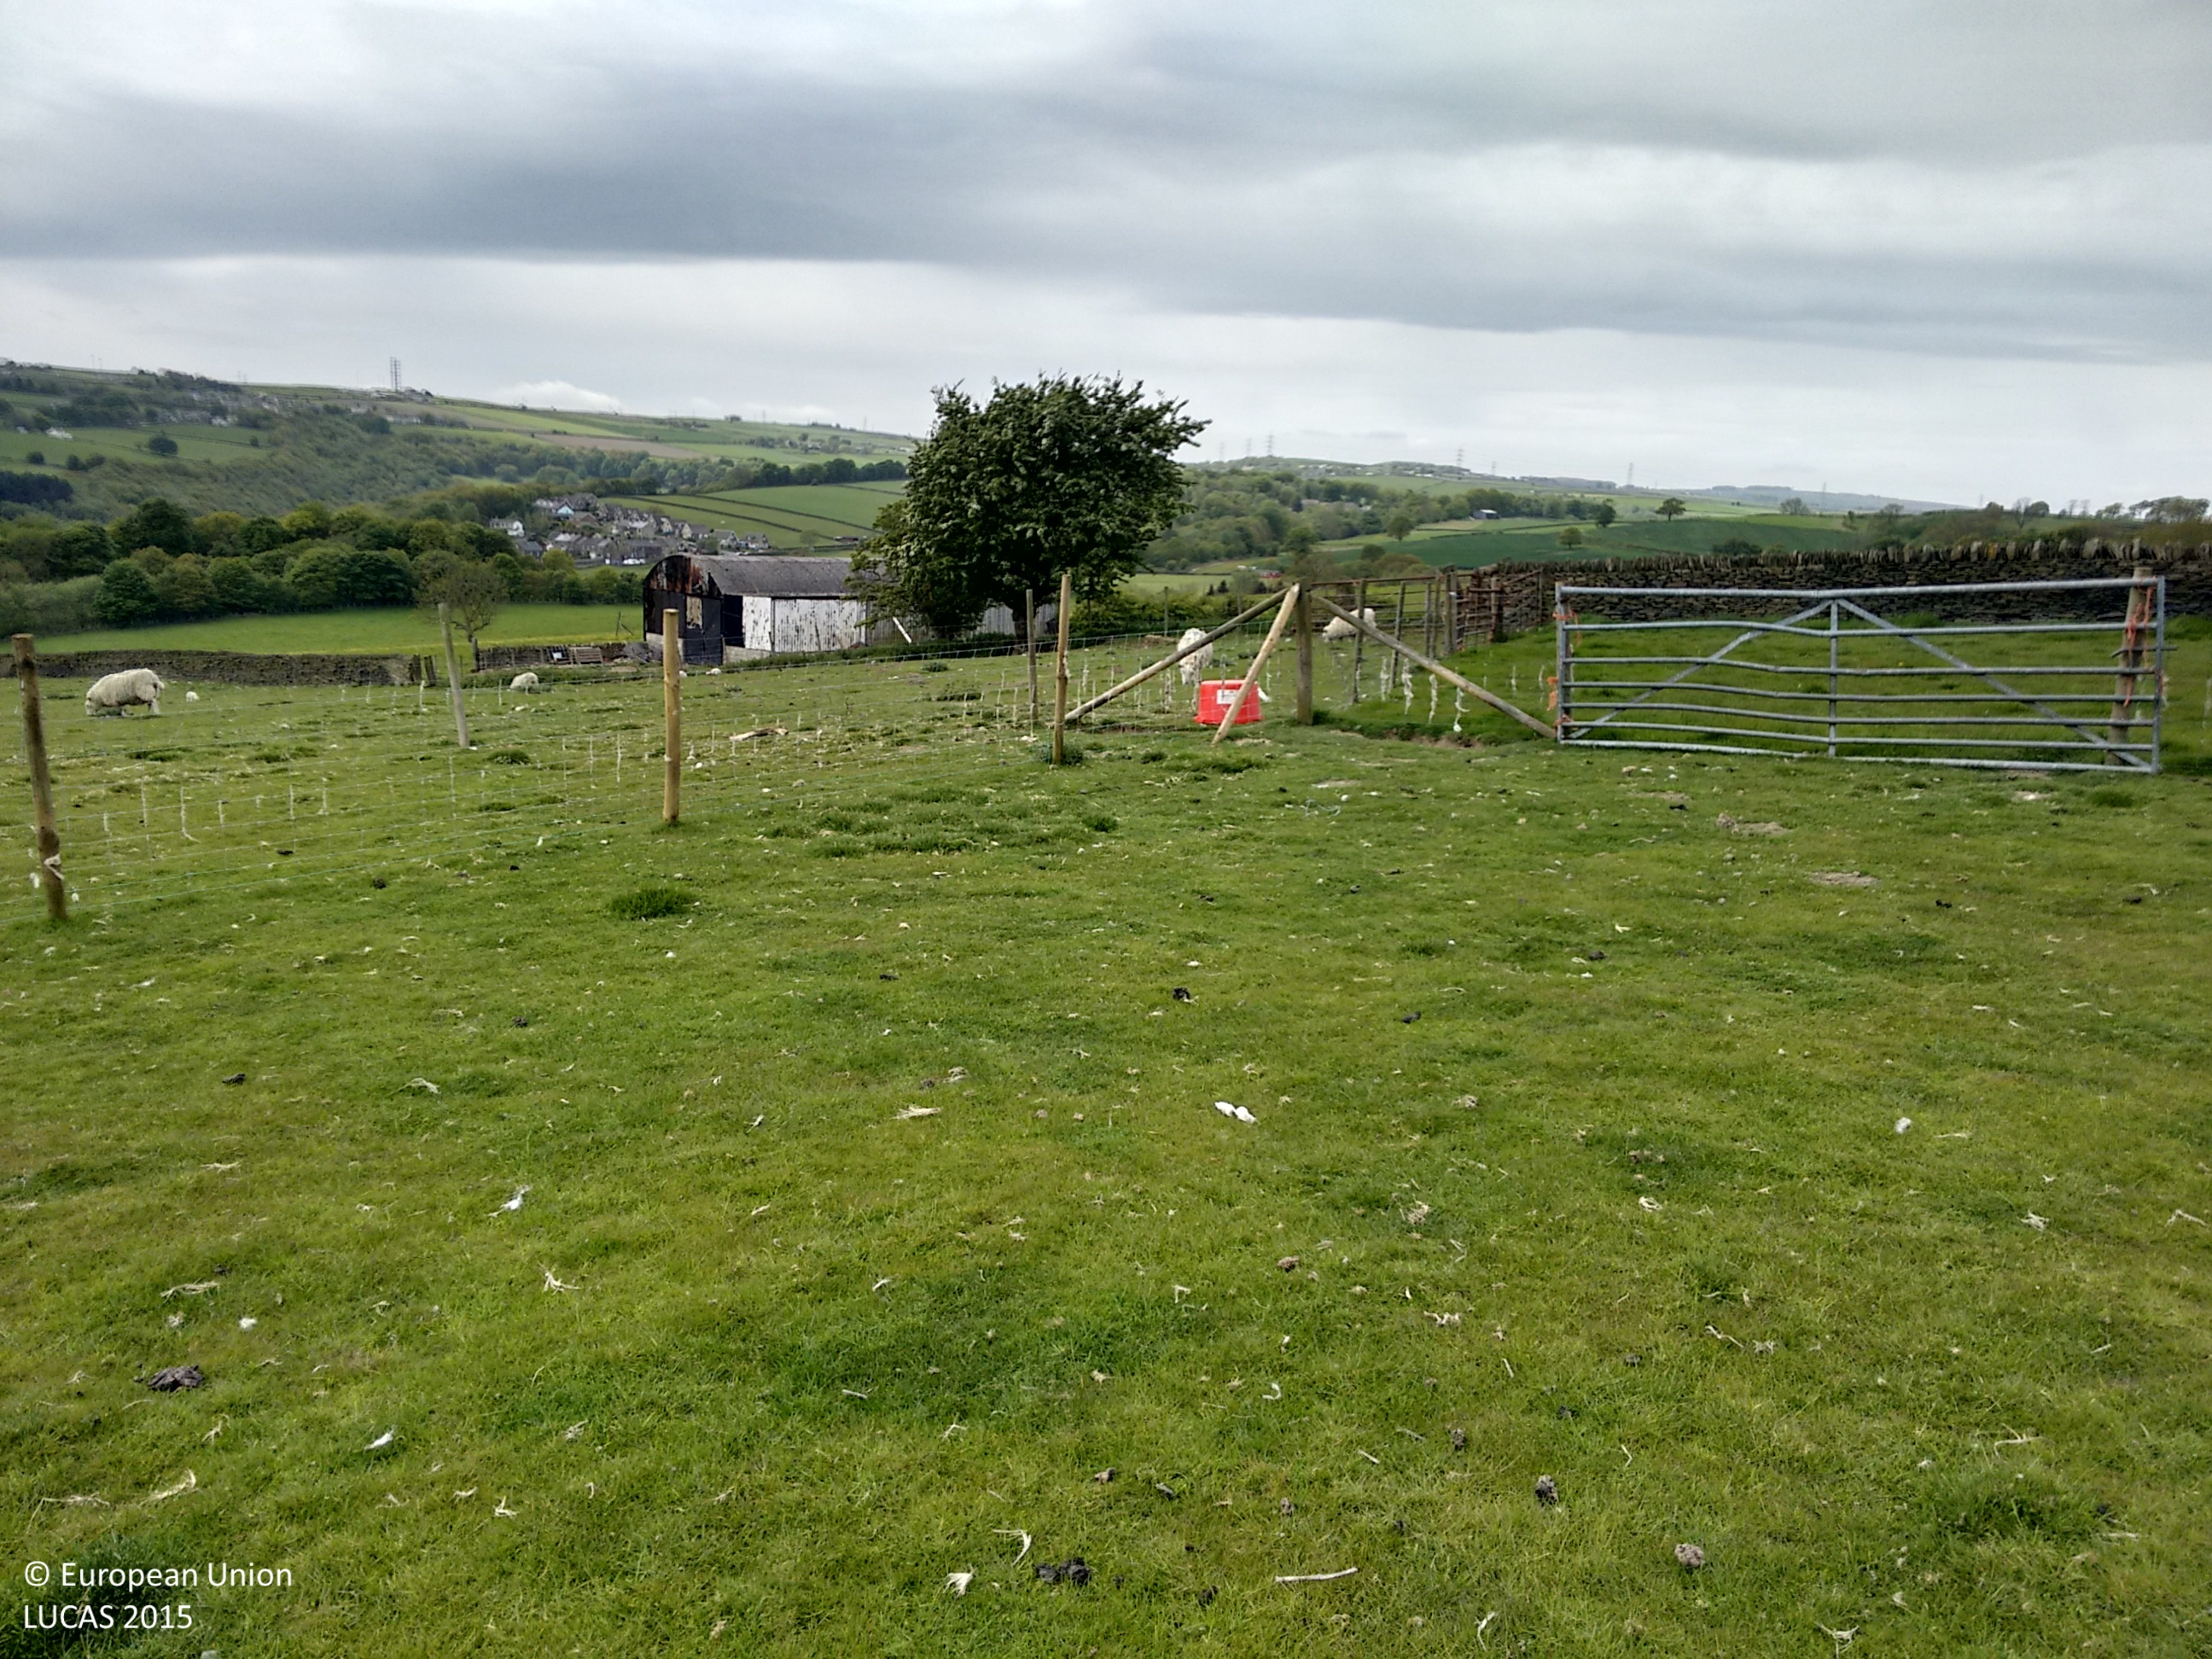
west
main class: Grassland
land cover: Grassland without tree/shrub cover
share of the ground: > 75 %
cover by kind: herbaceous plants 100 %
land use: Agriculture (excluding fallow land and kitchen gardens)
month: May
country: GB
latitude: 53.5009
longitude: -1.5537
